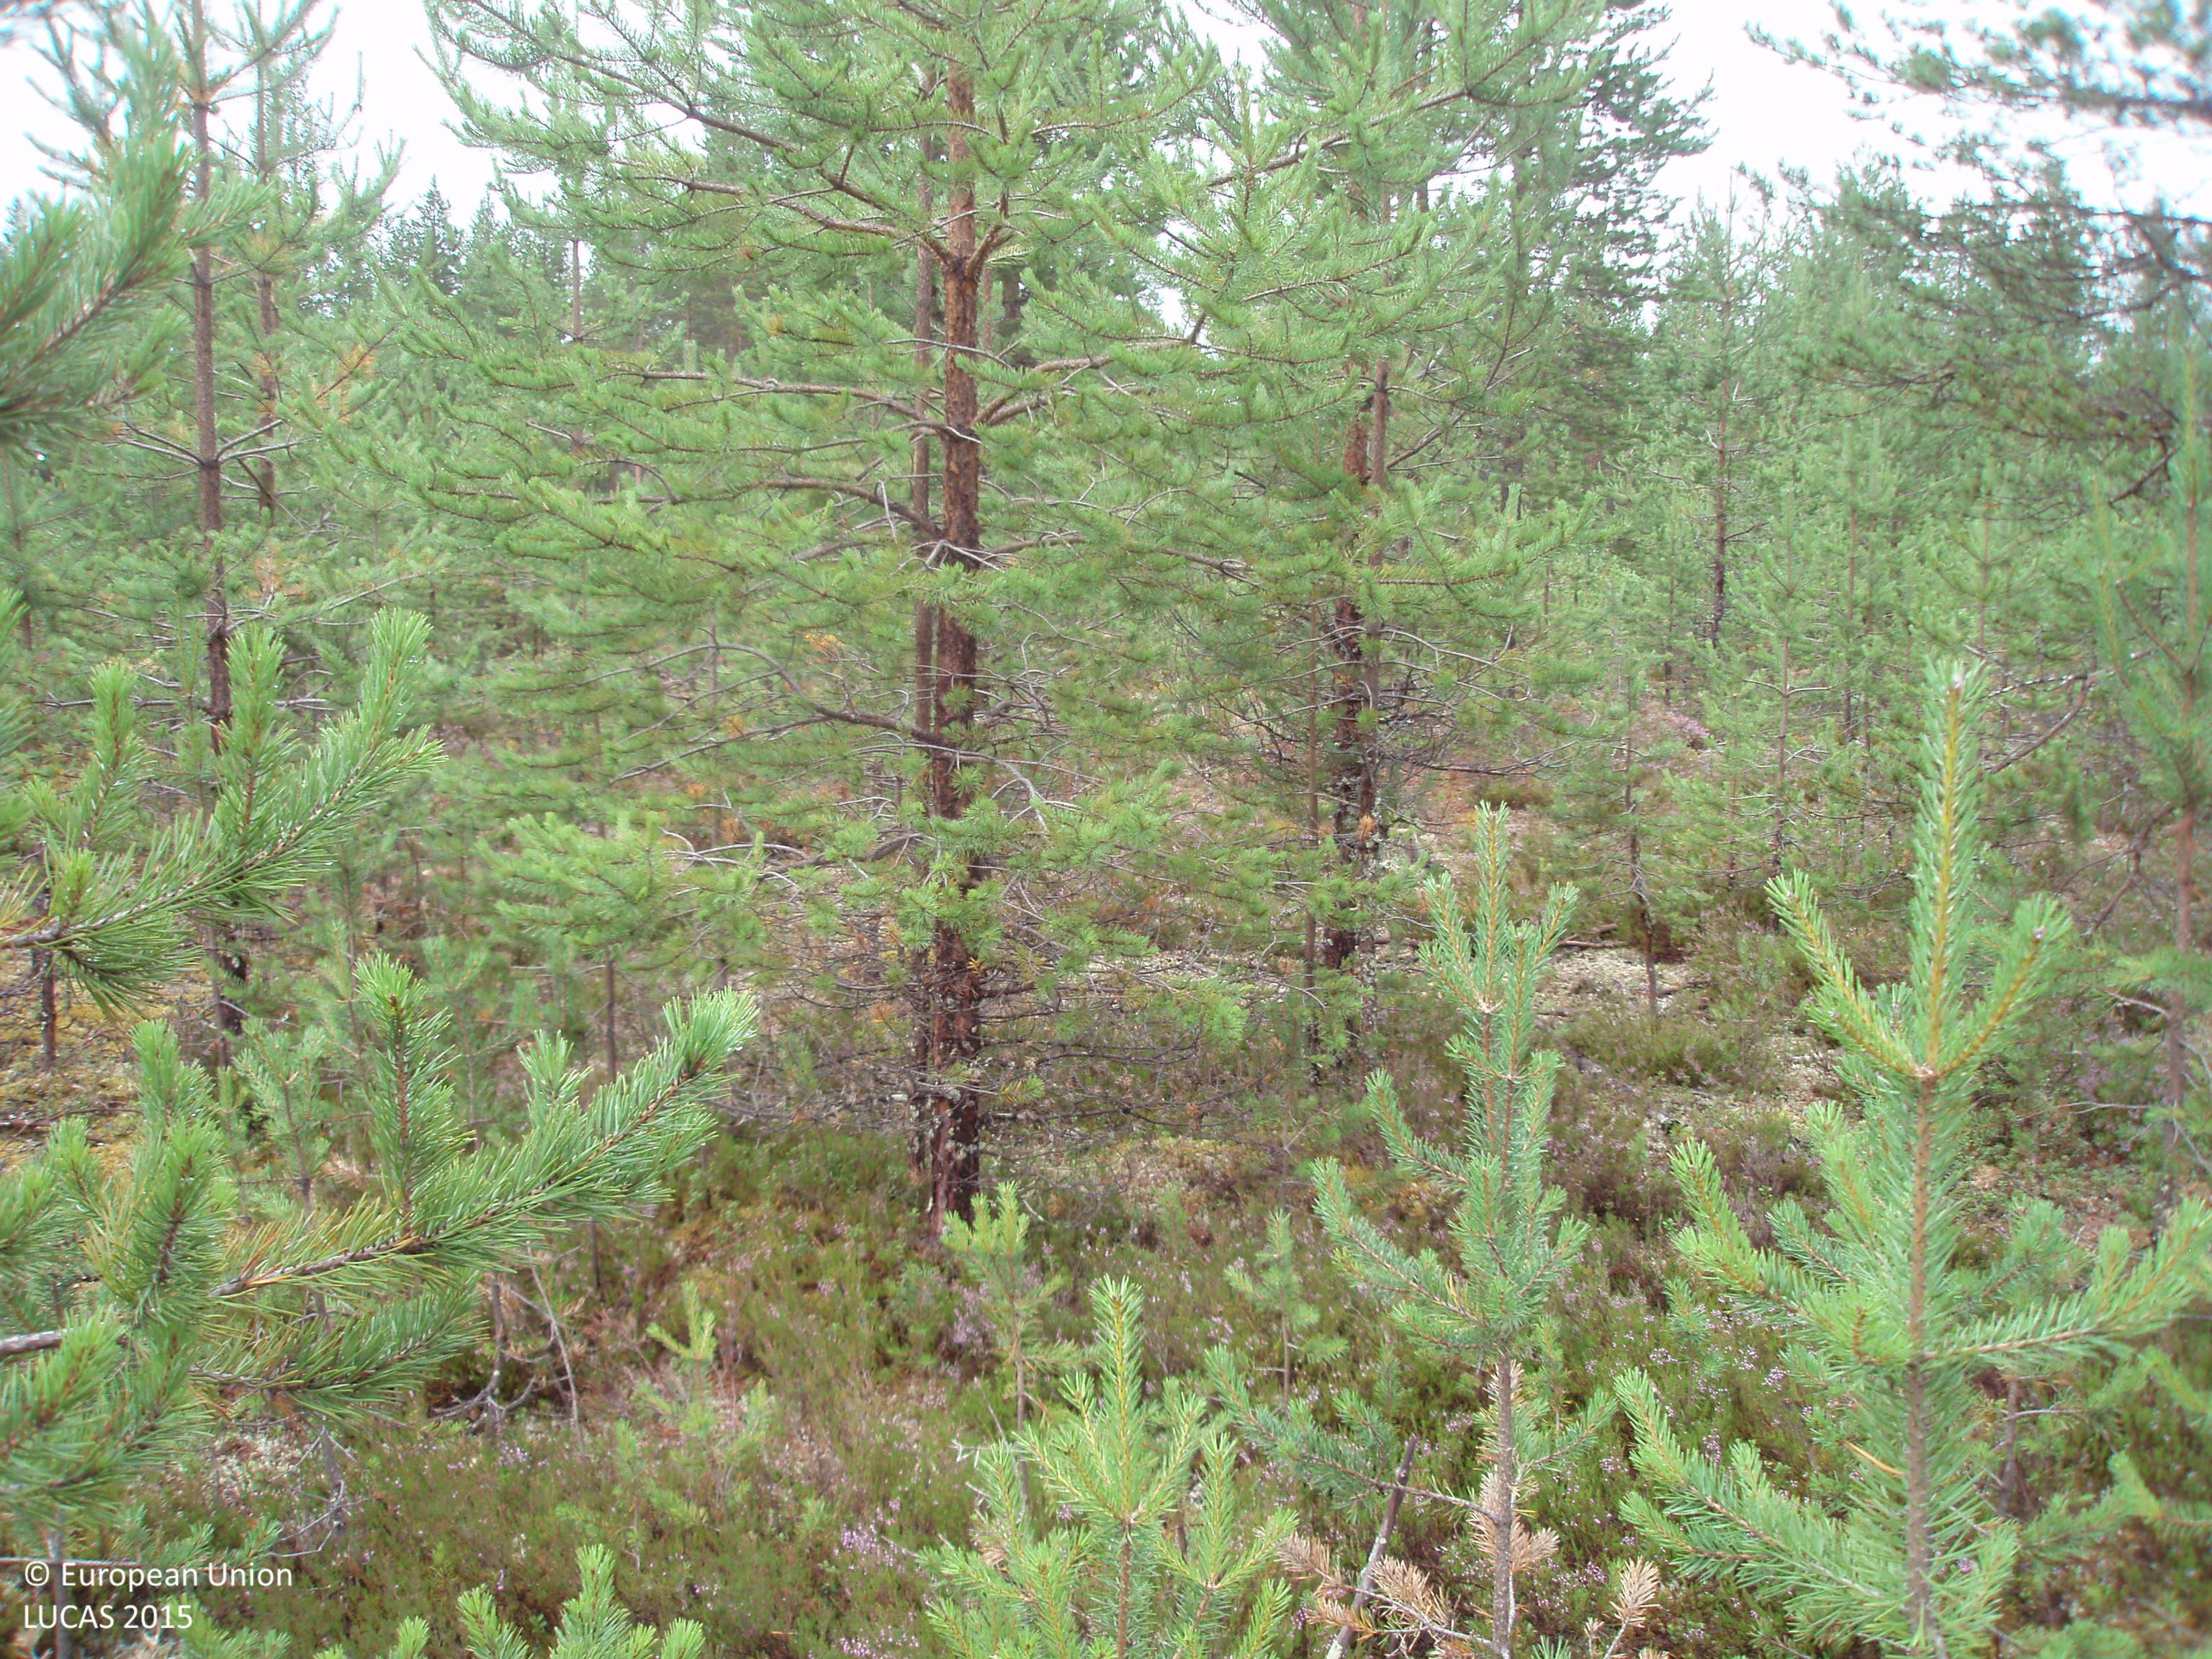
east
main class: Woodland
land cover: Pine dominated coniferous woodland
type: boreal forest
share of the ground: 25 - 50 %
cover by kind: shrubs 60 %, coniferous forest trees 40 %
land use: Forestry
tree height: < 5 m
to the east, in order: Pine dominated coniferous woodland; Tracks; Pine dominated coniferous woodland; Pine dominated mixed woodland; Other mixed woodland; Broadleaved woodland; Inland fresh running water
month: August
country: FI
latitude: 65.5889
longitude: 27.0063
